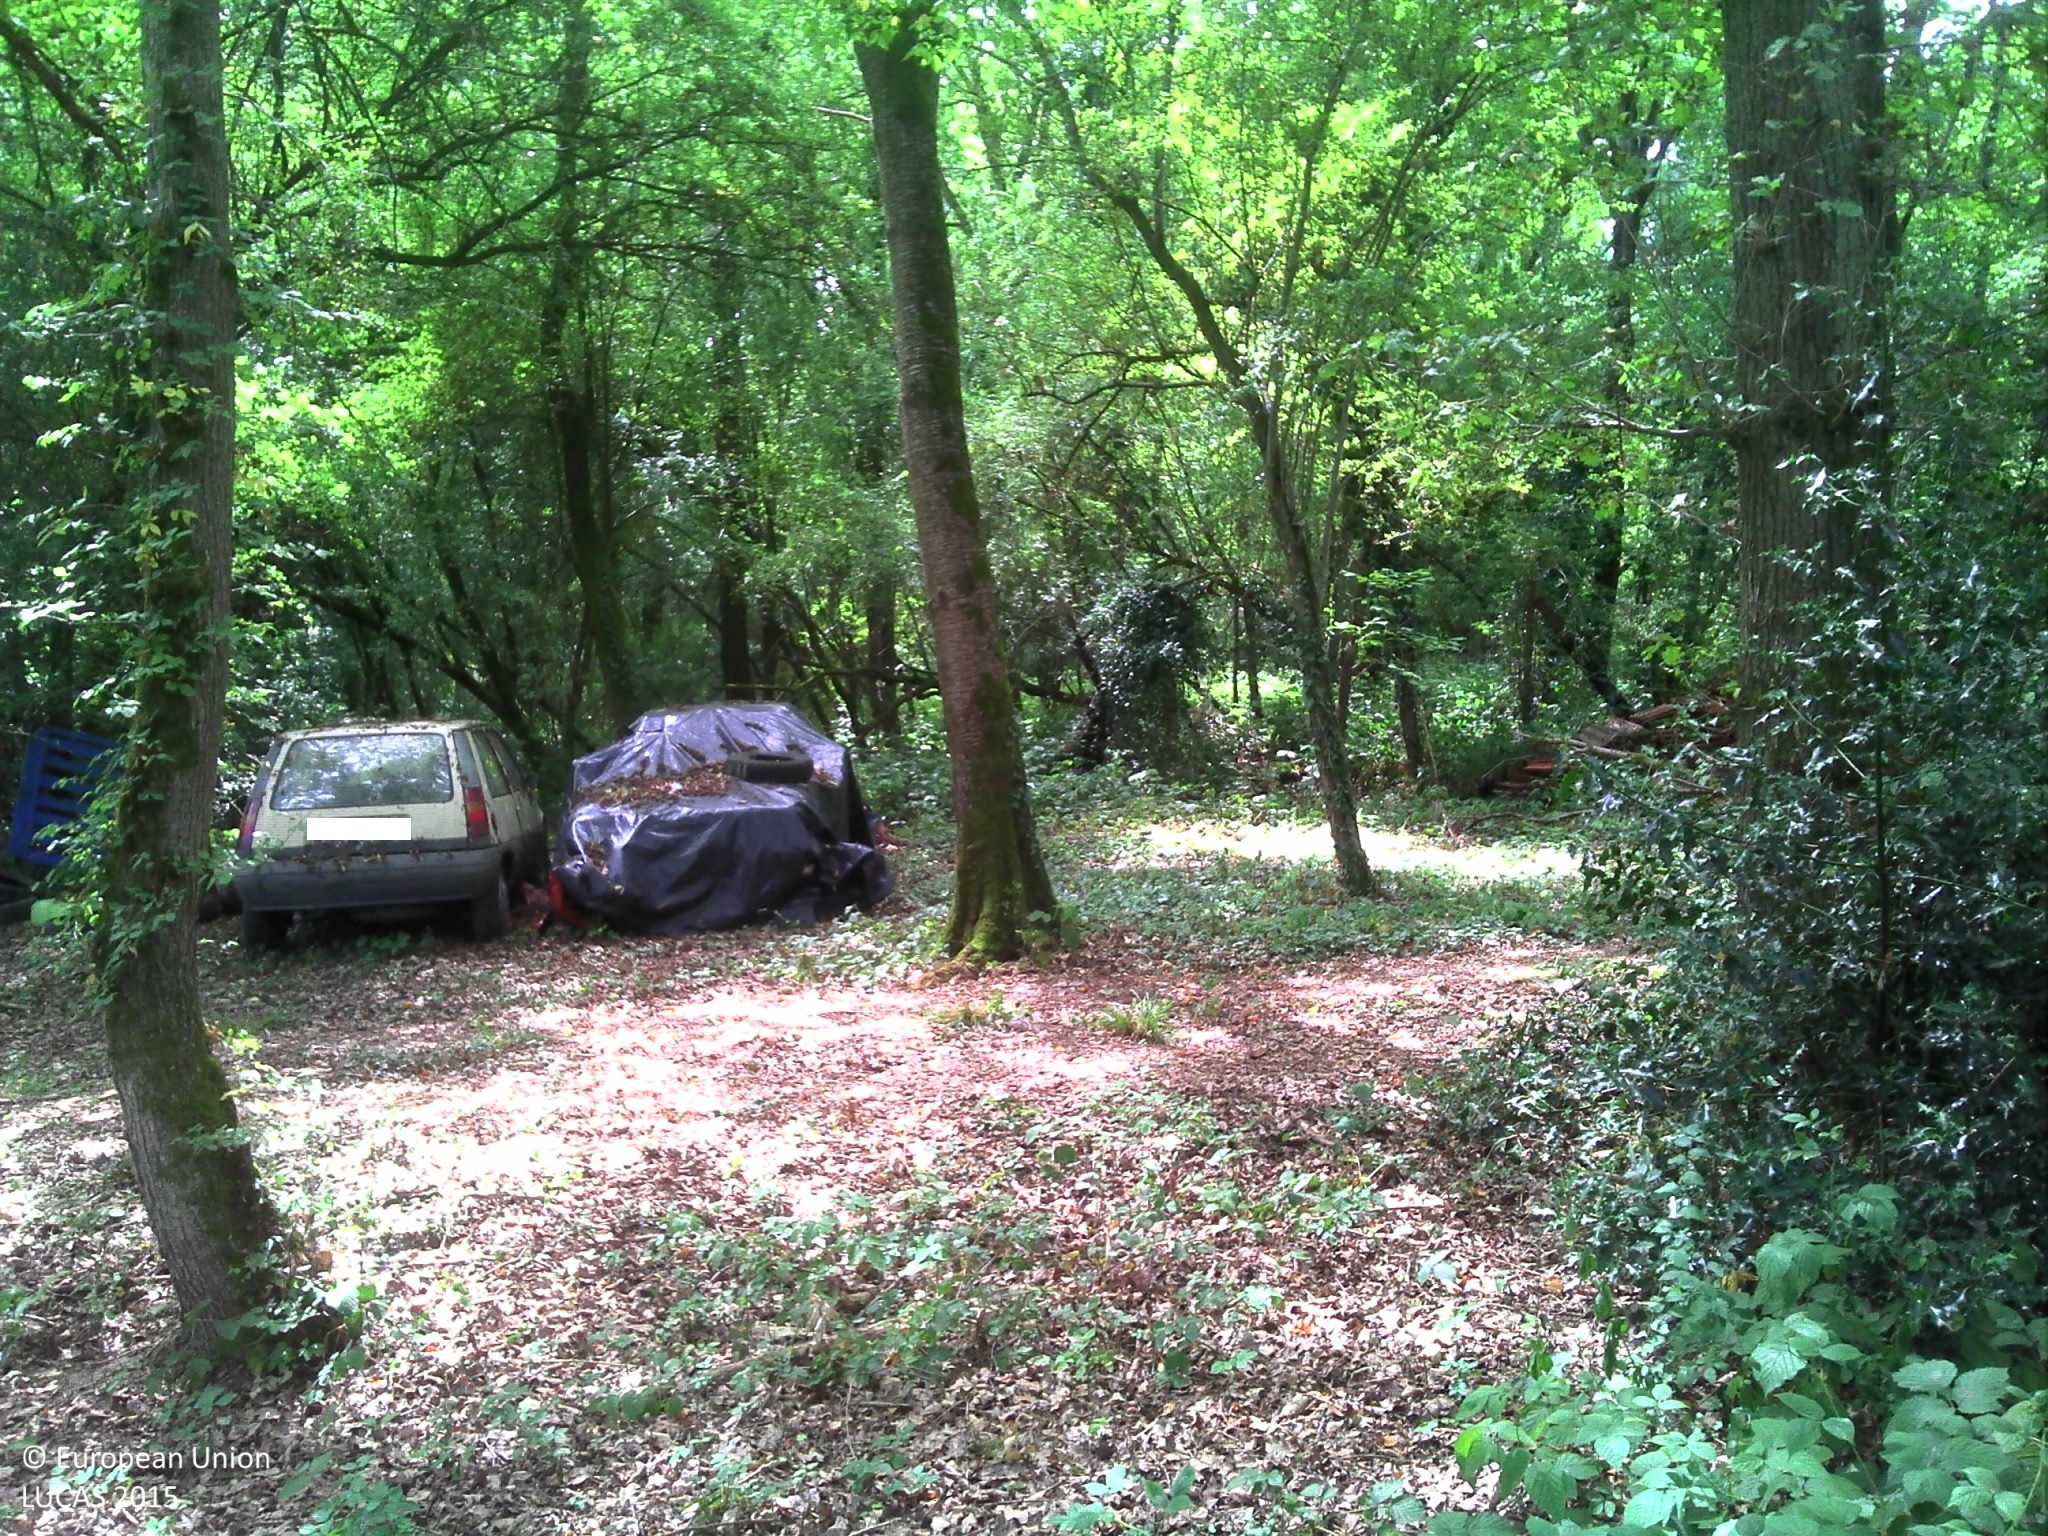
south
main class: Woodland
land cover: Broadleaved woodland
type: beech forest
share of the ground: > 75 %
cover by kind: broadleaved forest trees 40 %, herbaceous plants 20 %, lichens and mosses 20 %, unconsolidated bare surface 10 %
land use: Forestry
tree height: > 5 m
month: August
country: FR
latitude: 49.0631
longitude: 2.6673
